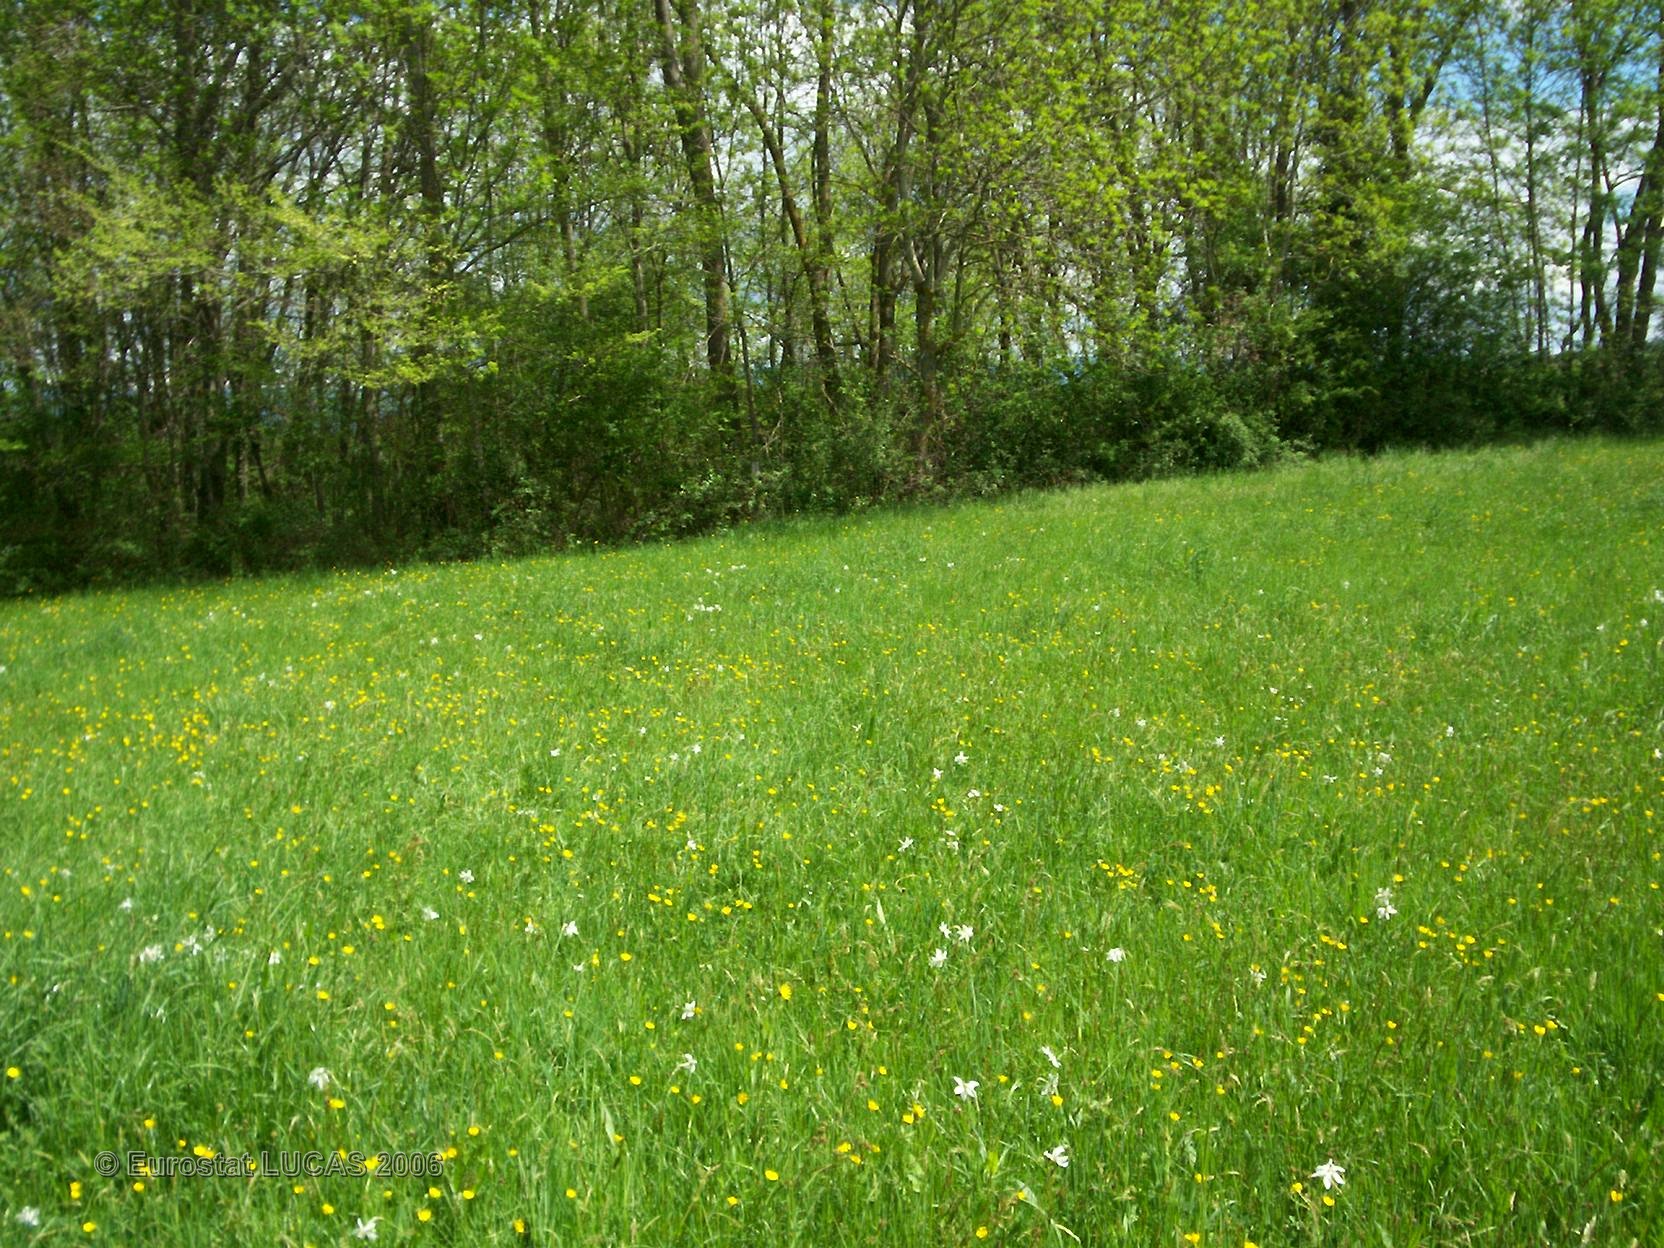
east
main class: Grassland
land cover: Grassland without tree/shrub cover
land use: Agriculture (excluding fallow land and kitchen gardens)
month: May
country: FR
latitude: 45.2561
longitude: 3.3122
